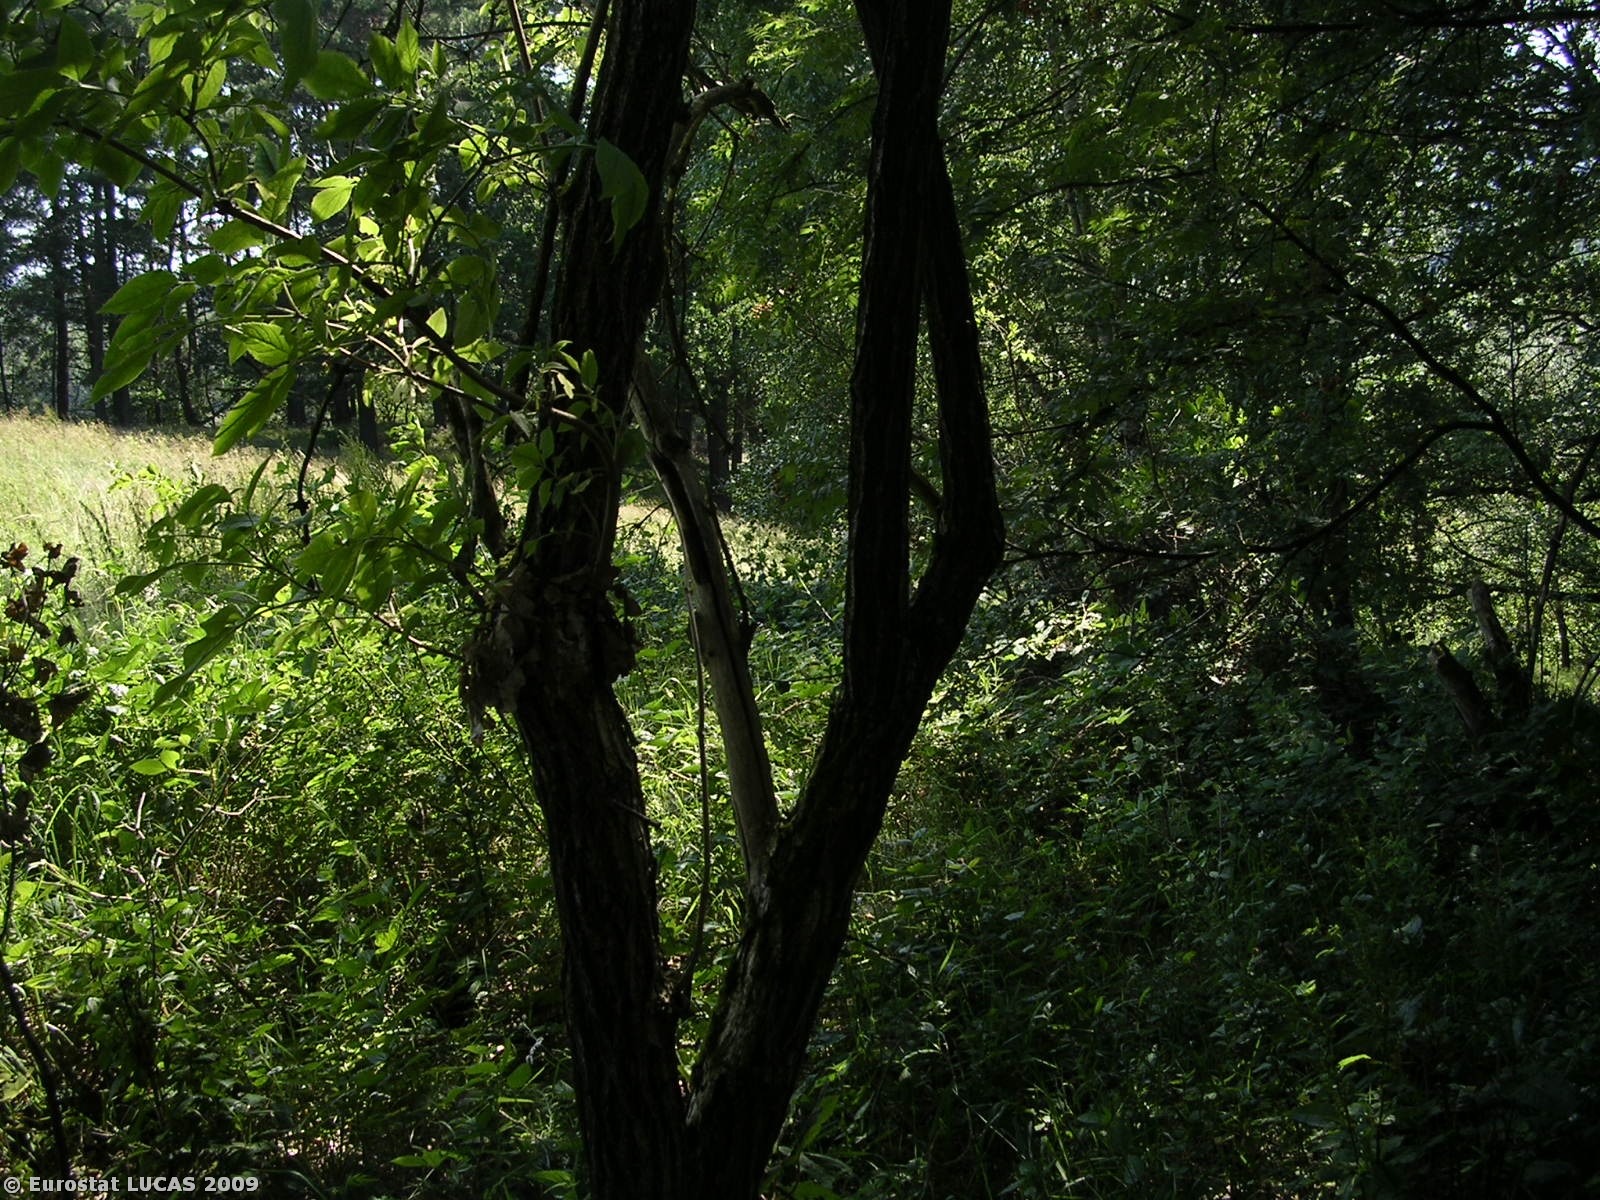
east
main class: Woodland
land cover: Broadleaved woodland
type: hemiboreal forest and nemoral coniferous forest and mixed broadleaved-coniferous forest
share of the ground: > 75 %
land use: Nature reserves
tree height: > 5 m
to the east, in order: Broadleaved woodland; Grassland without tree/shrub cover; Mixed woodland; Grassland without tree/shrub cover; Broadleaved woodland; Grass margins; Tracks; Grass margins; Electric lines; Spontaneously vegetated surfaces; Grassland without tree/shrub cover
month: July
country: CZ
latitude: 50.8413
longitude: 14.3045
